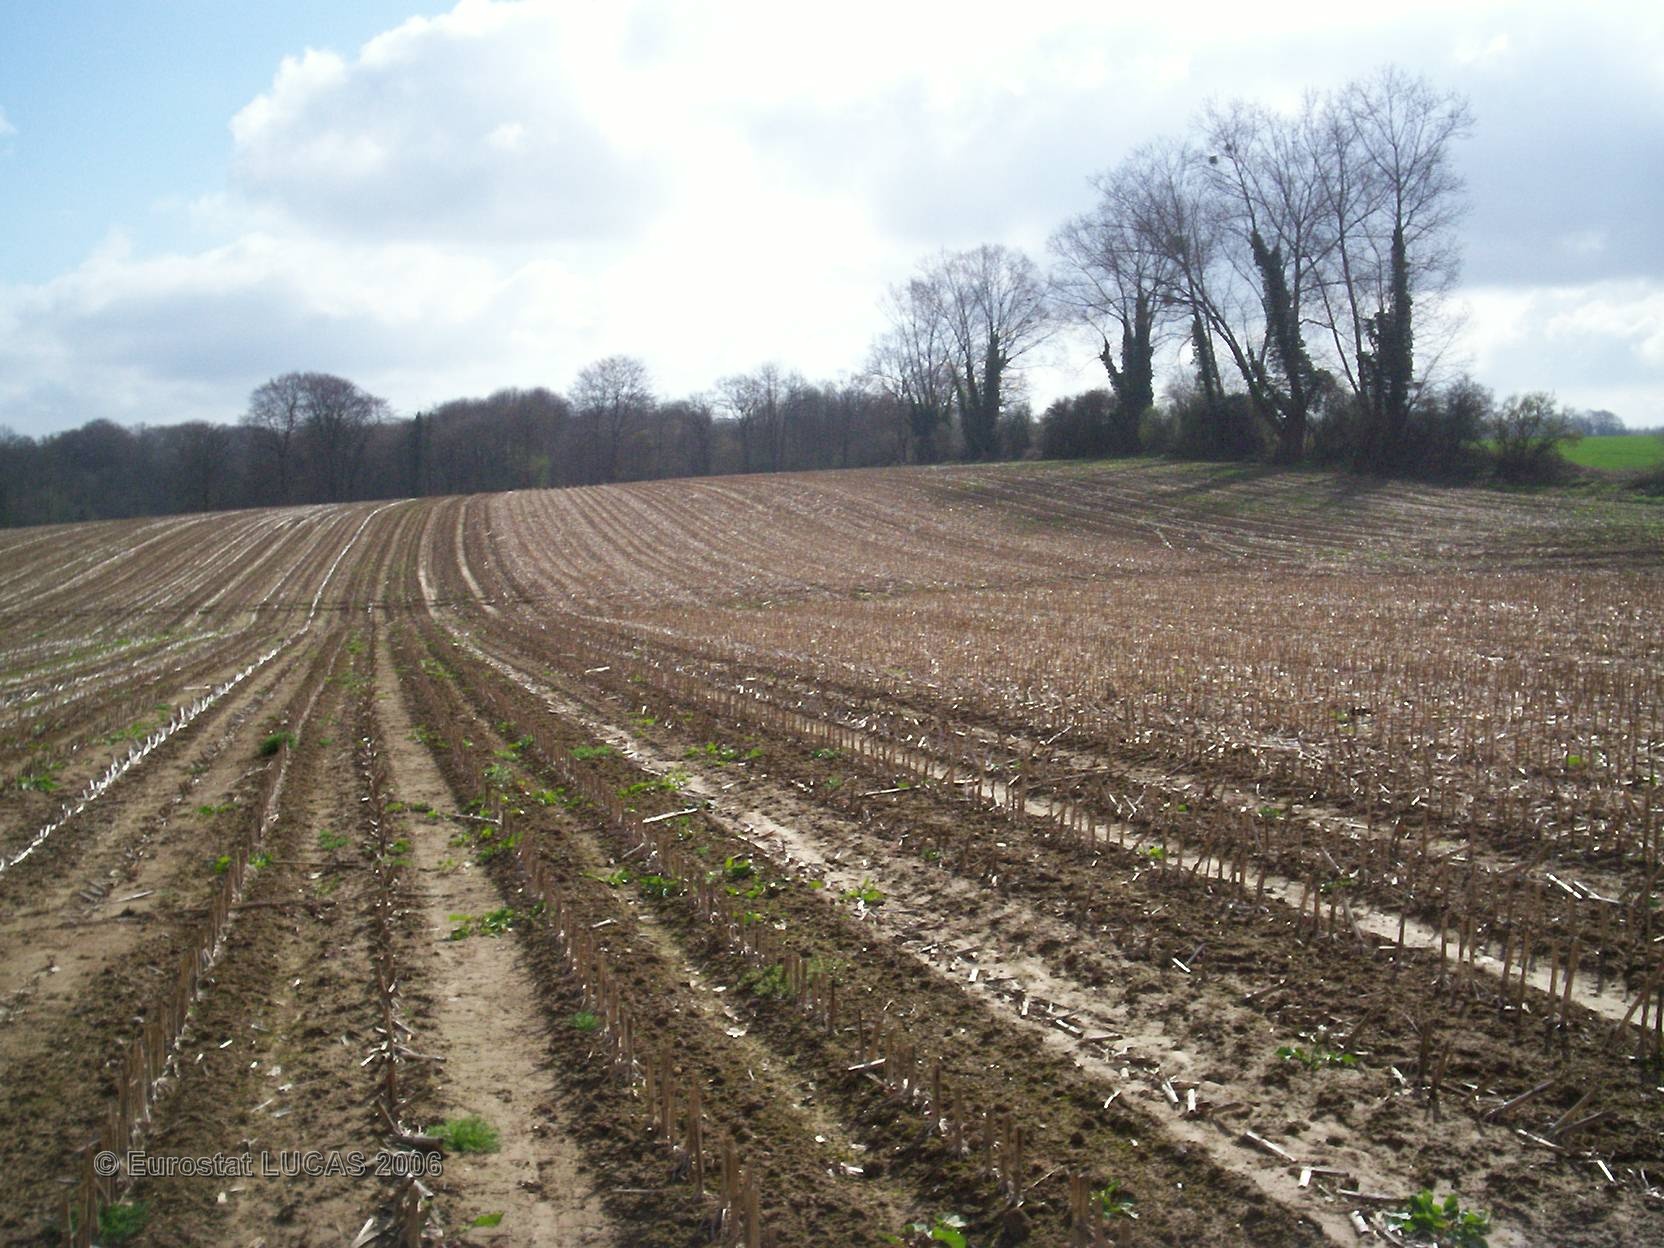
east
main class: Cropland
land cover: Maize
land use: Agriculture (excluding fallow land and kitchen gardens)
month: May
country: FR
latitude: 49.7395
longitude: 0.8037
